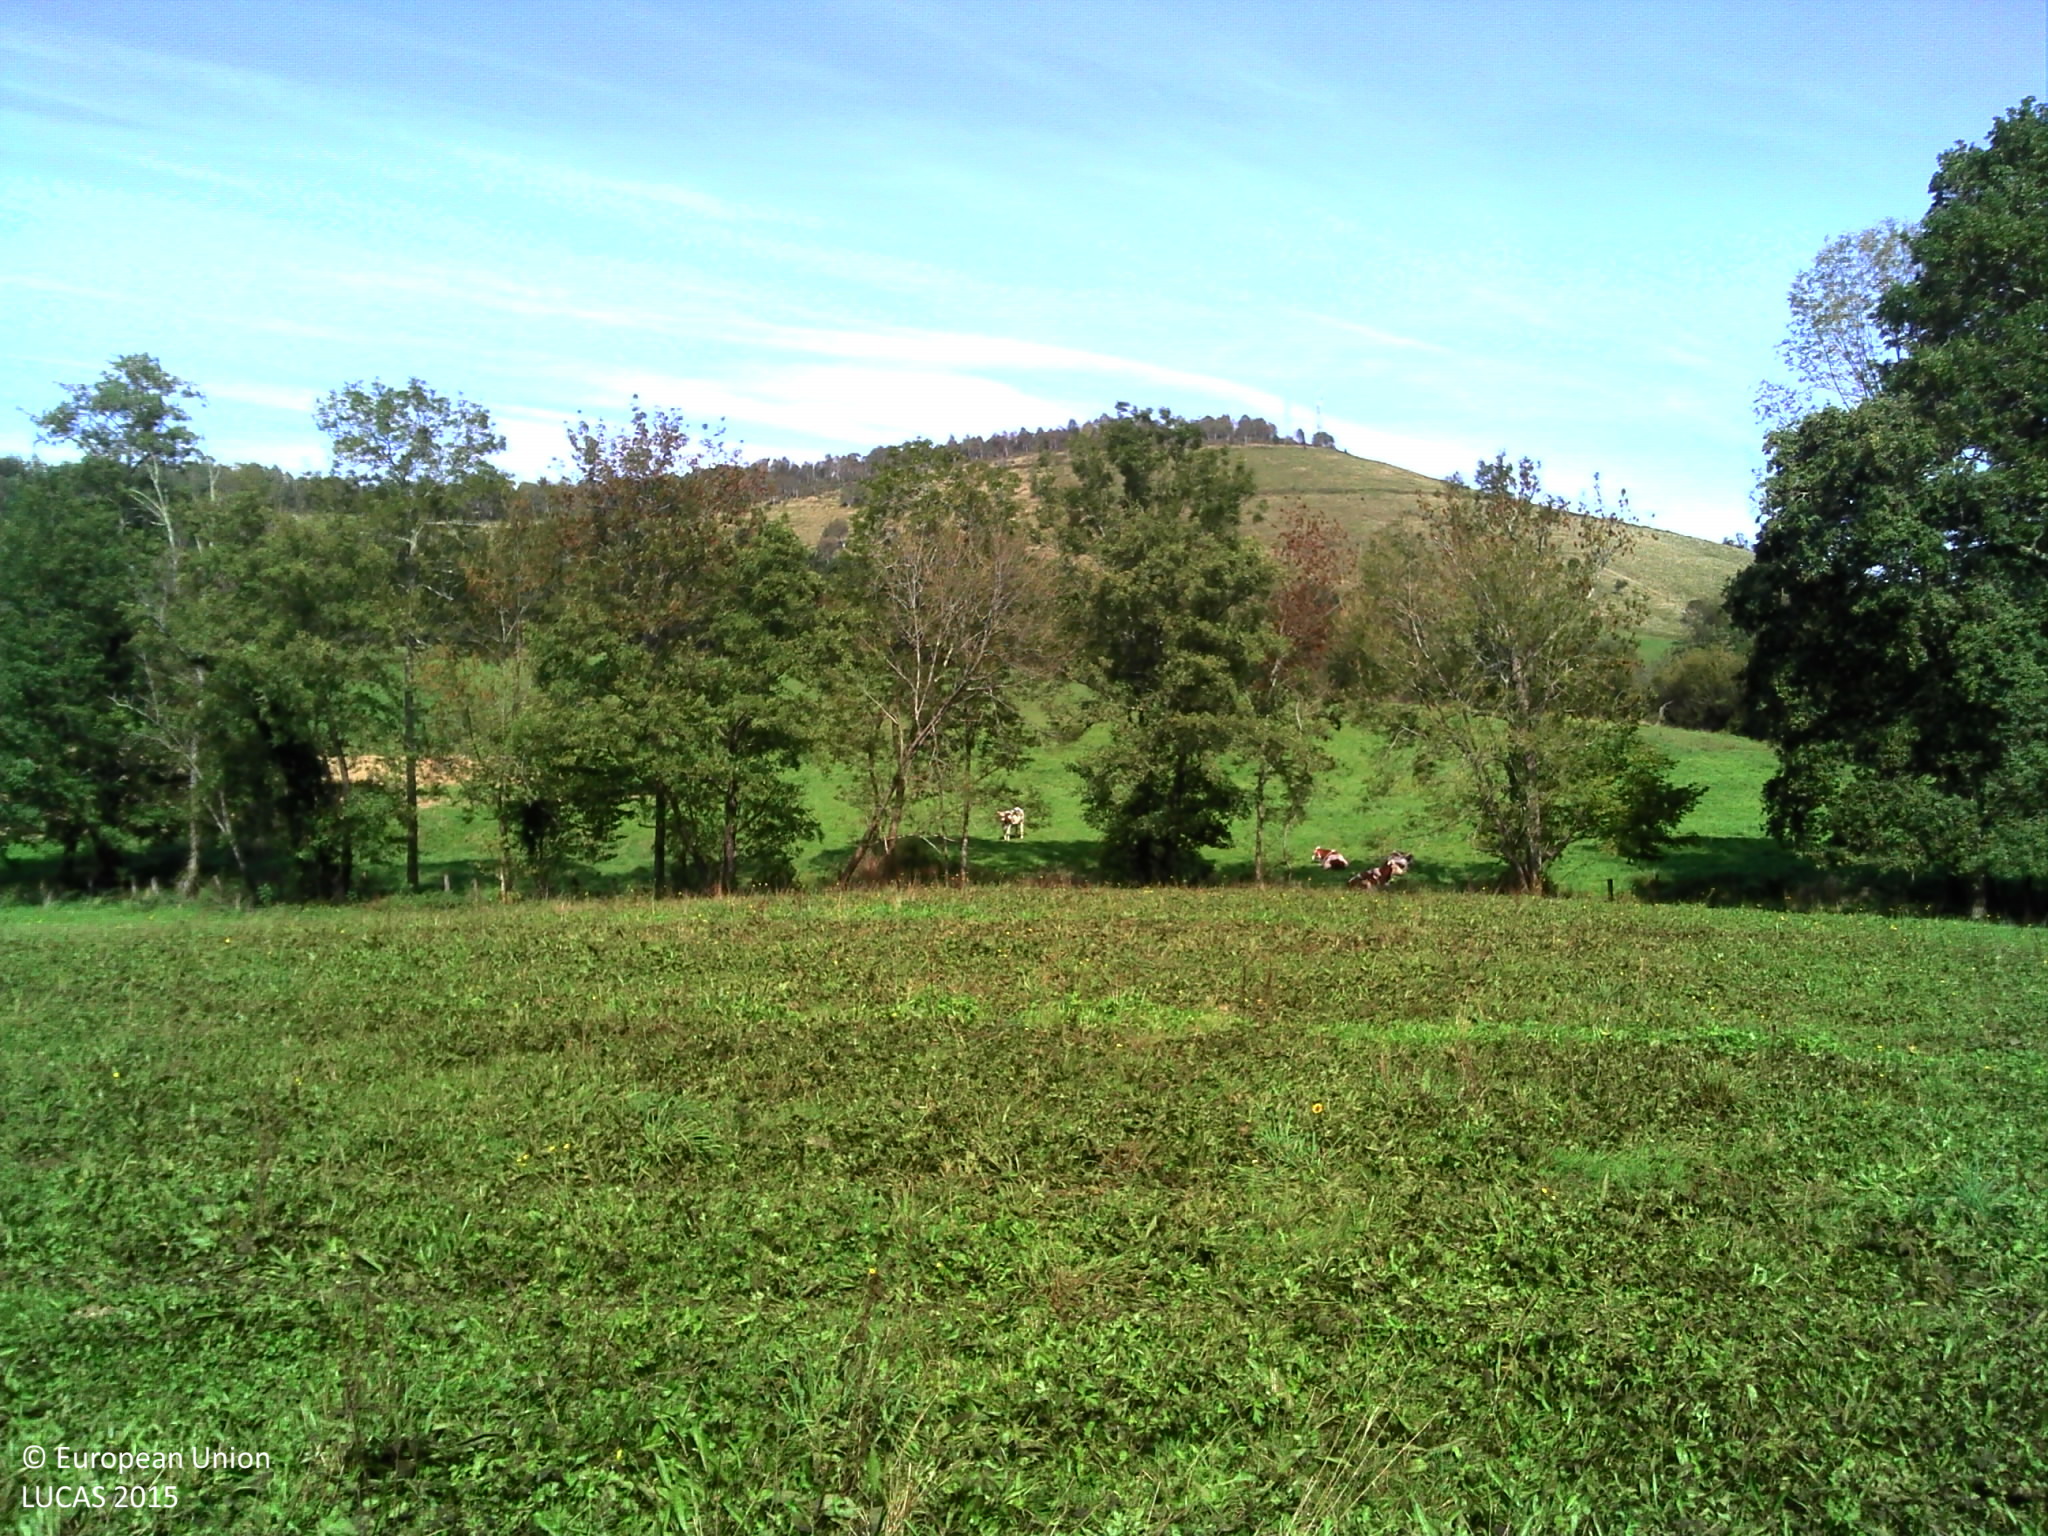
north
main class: Grassland
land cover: Grassland without tree/shrub cover
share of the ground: > 75 %
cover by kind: herbaceous plants 100 %
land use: Agriculture (excluding fallow land and kitchen gardens)
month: September
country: FR
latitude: 43.1316
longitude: -0.6164
